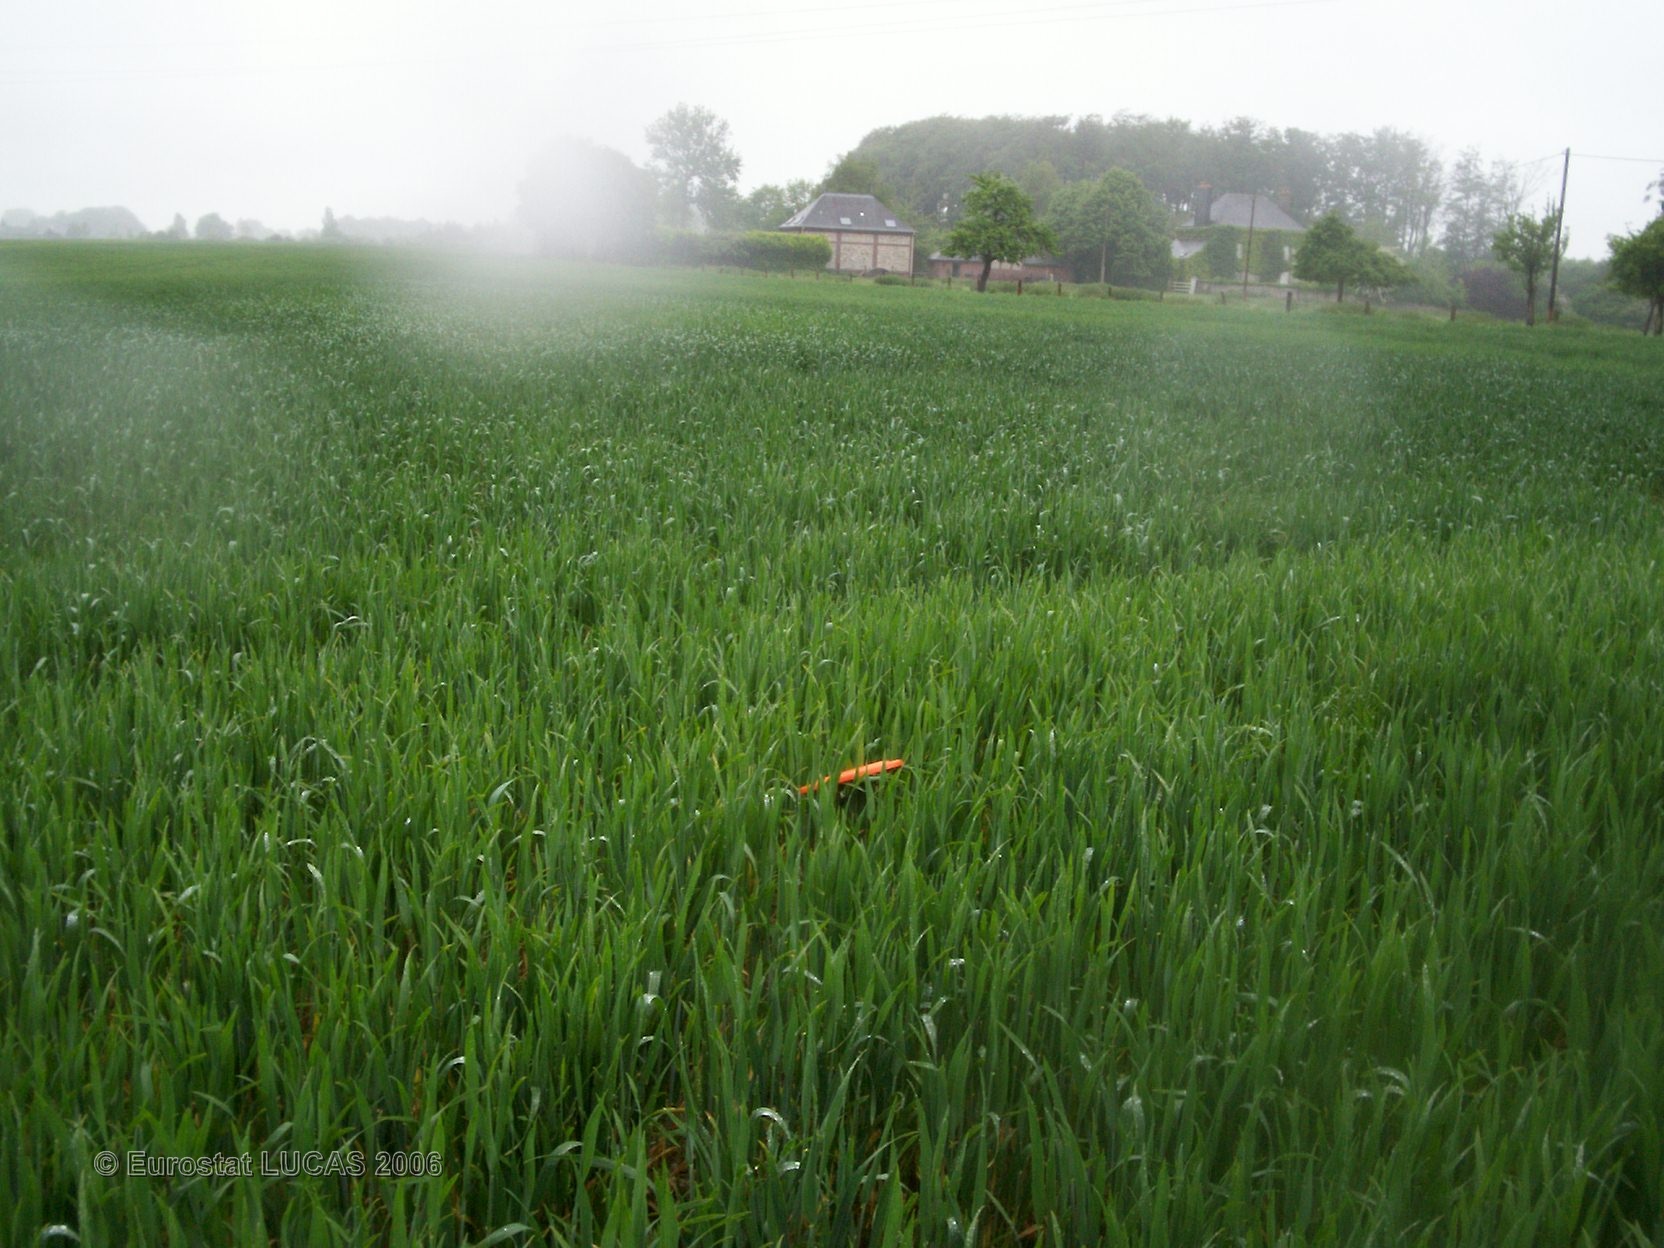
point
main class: Cropland
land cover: Common wheat
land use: Agriculture (excluding fallow land and kitchen gardens)
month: May
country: FR
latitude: 49.7298
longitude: 0.4696
